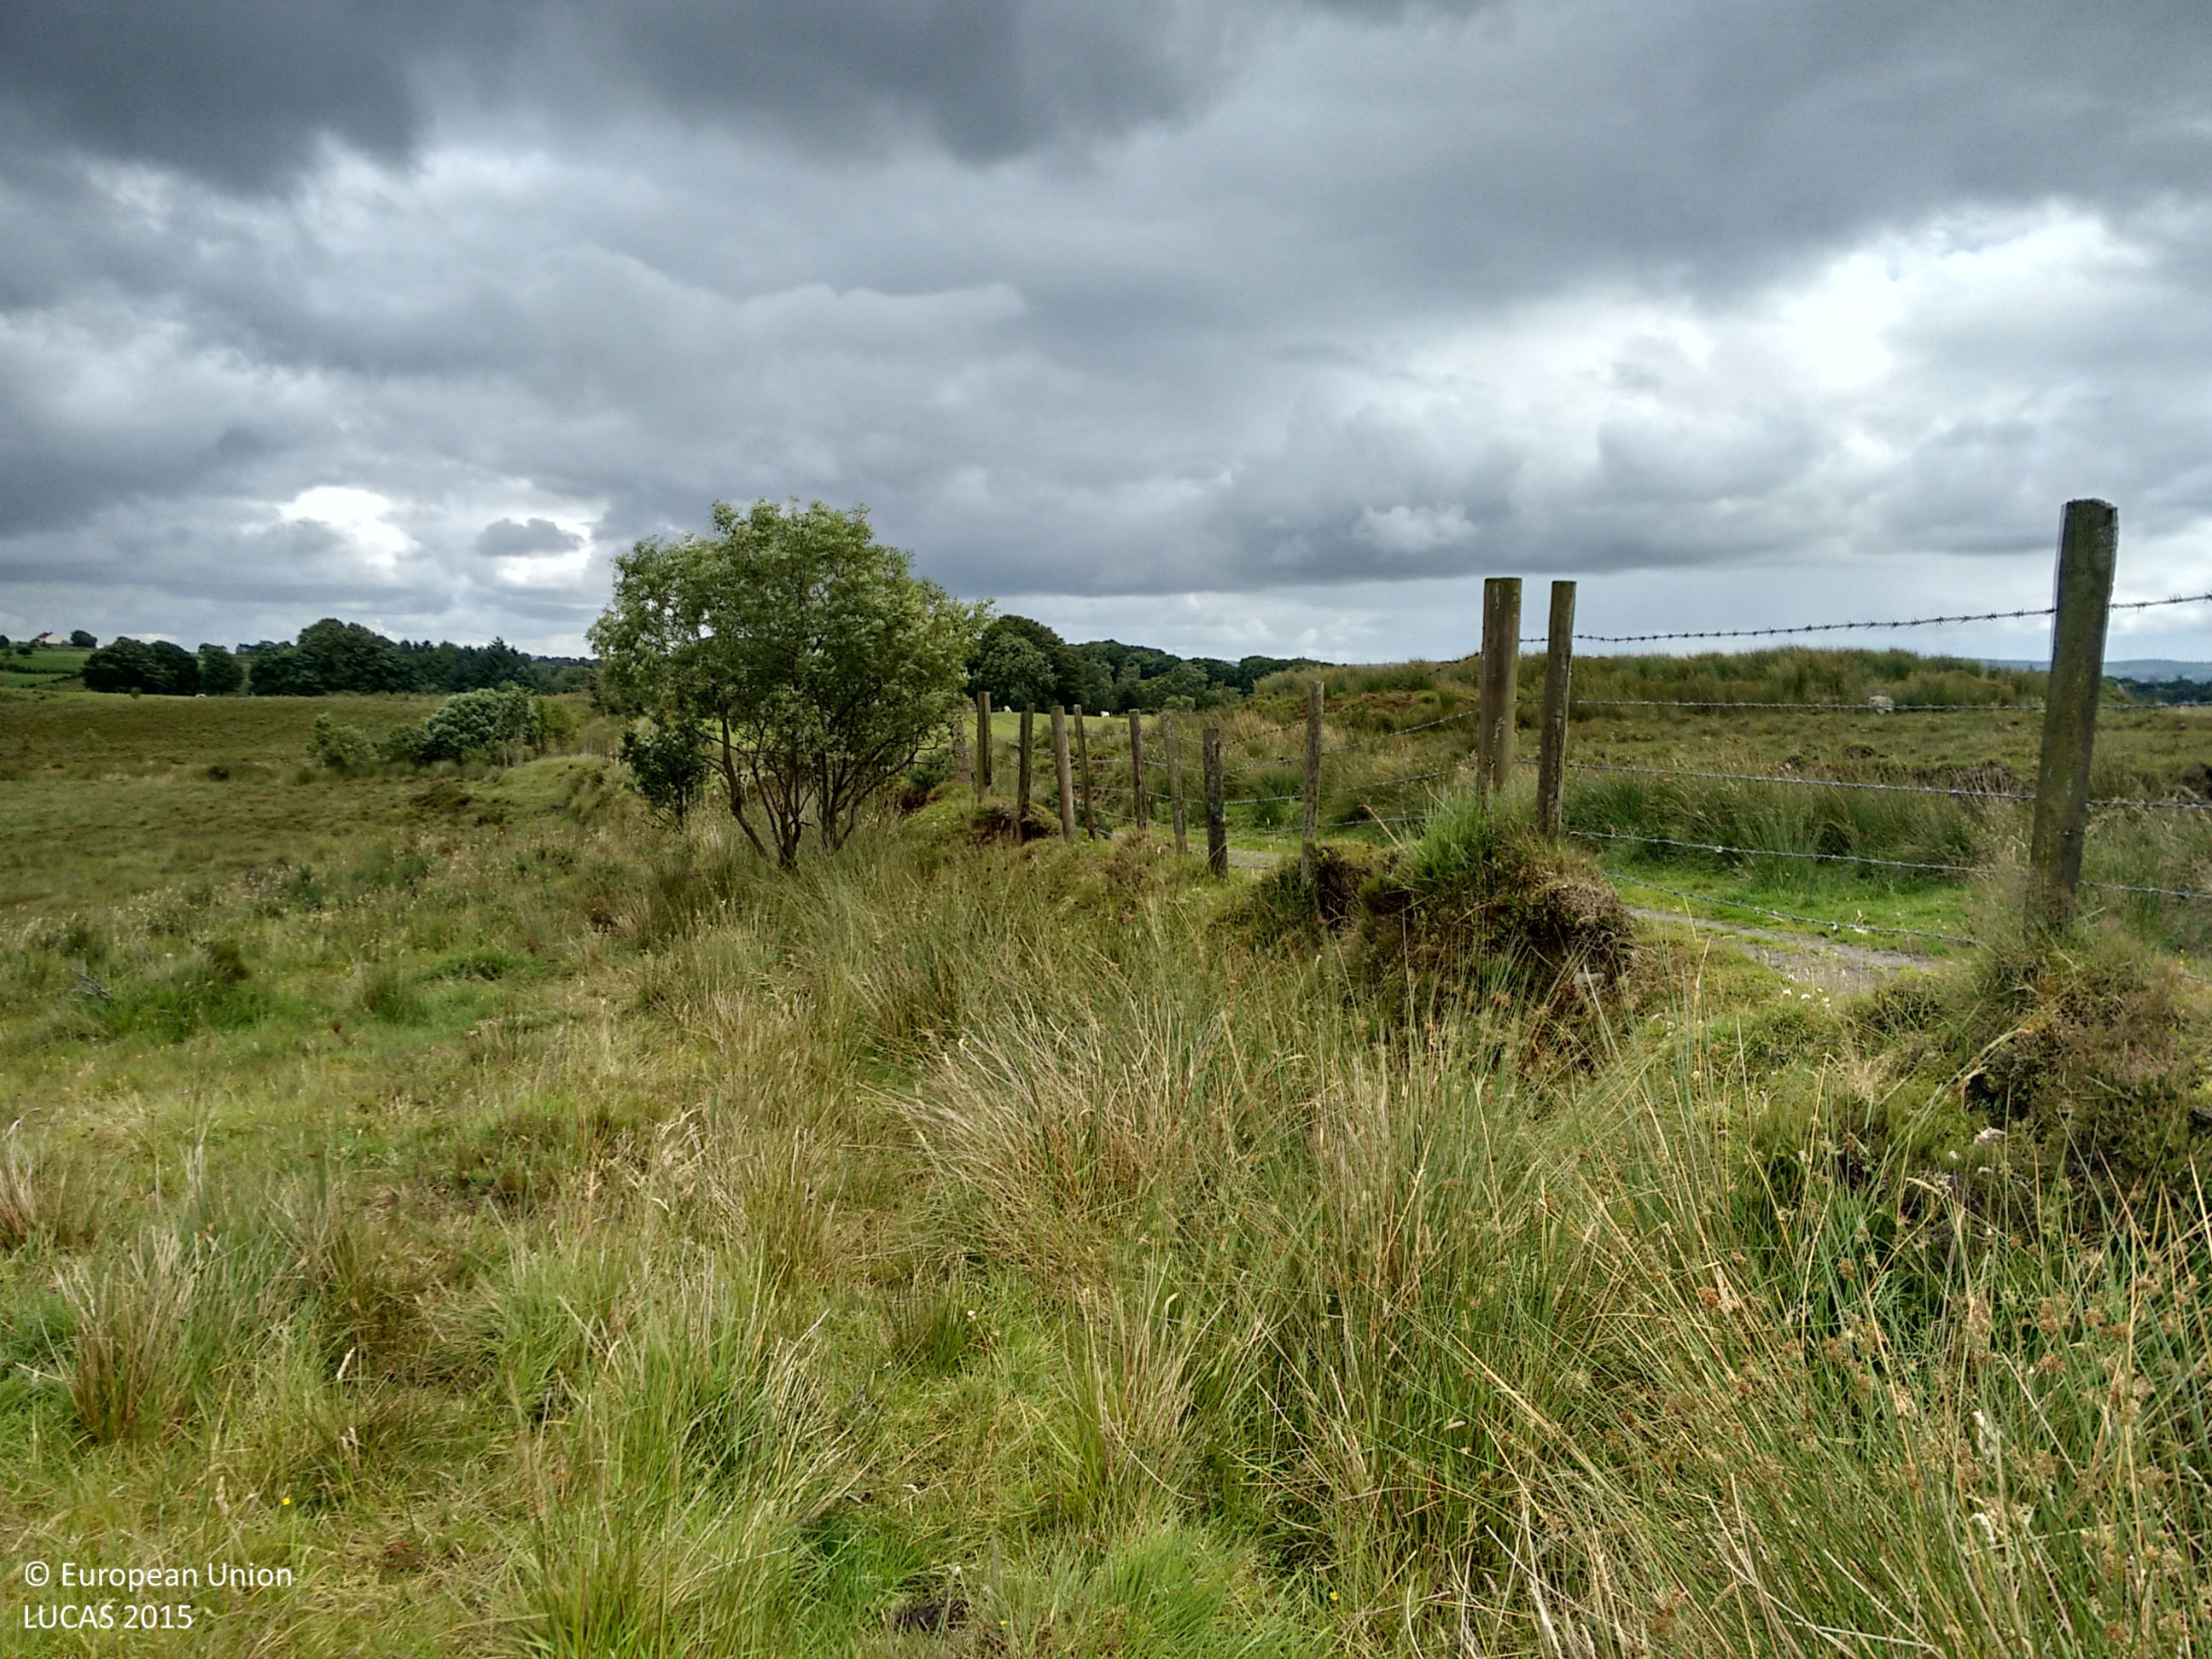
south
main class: Grassland
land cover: Grassland without tree/shrub cover
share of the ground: > 75 %
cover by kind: herbaceous plants 100 %
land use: Agriculture (excluding fallow land and kitchen gardens)
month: July
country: GB
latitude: 54.6384
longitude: -7.1083
